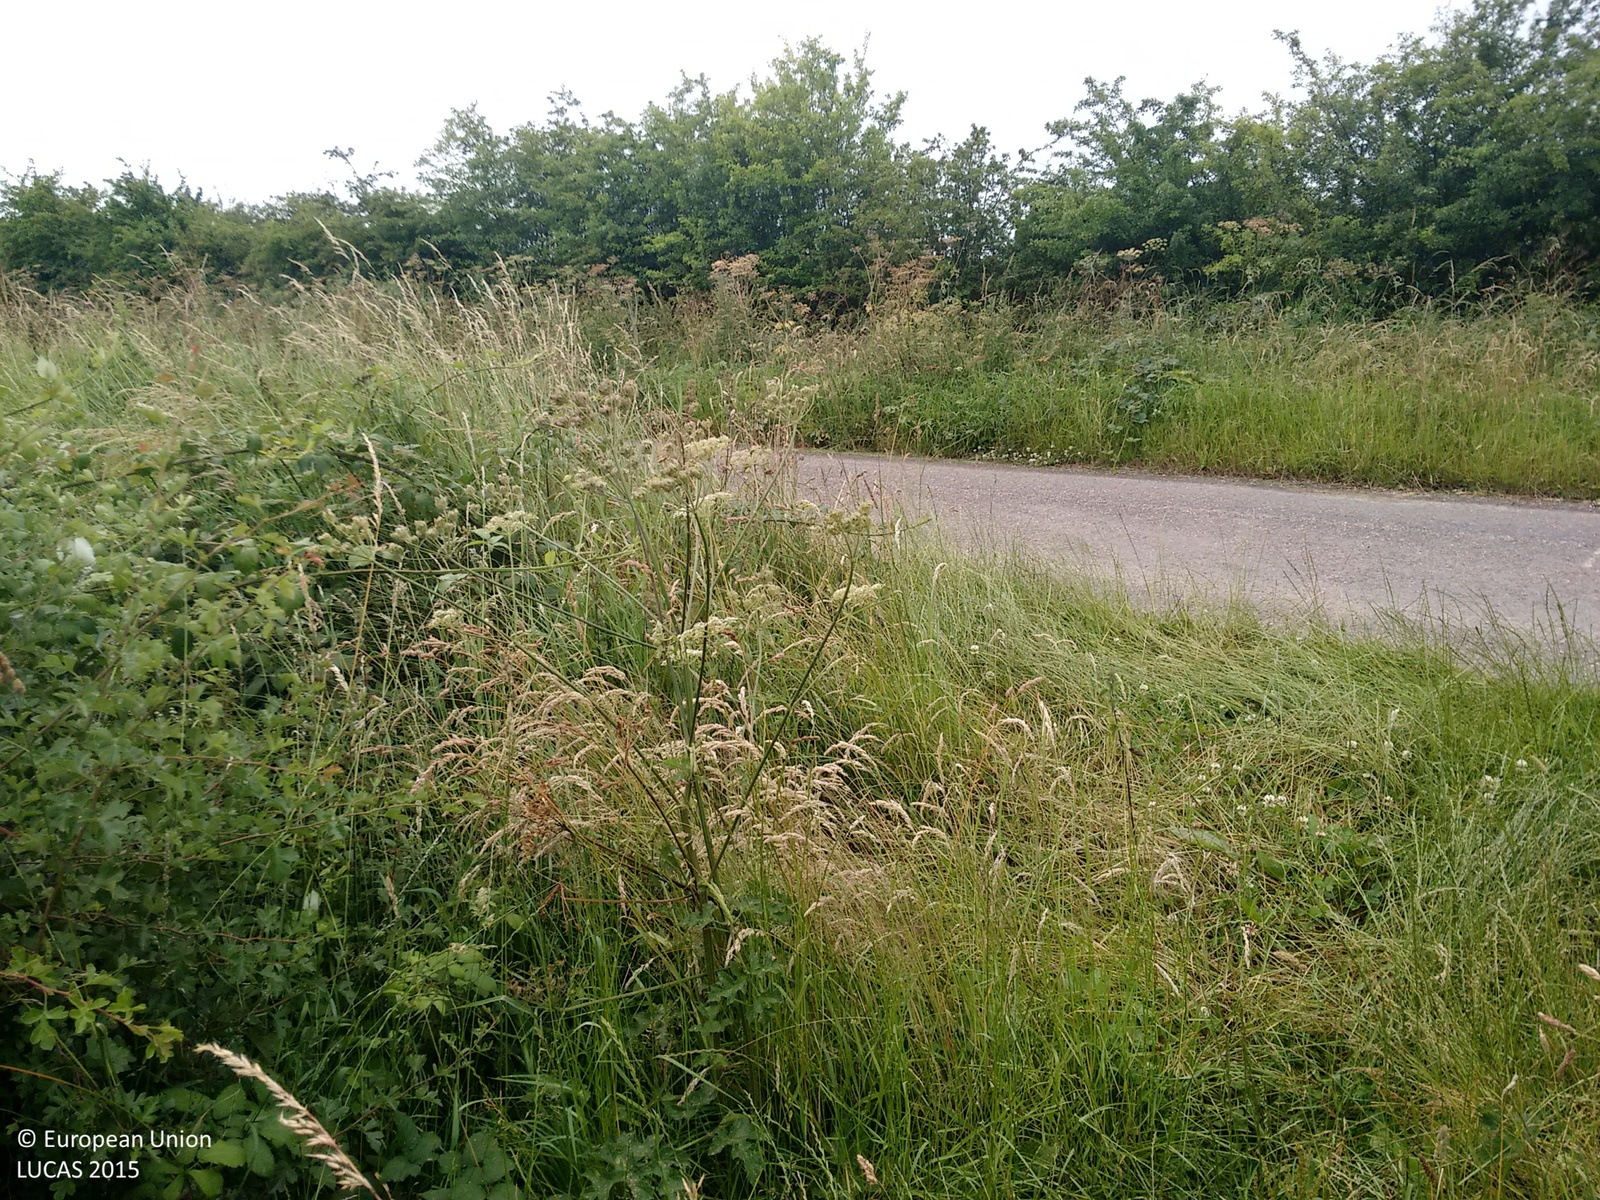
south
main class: Grassland
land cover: Grassland without tree/shrub cover
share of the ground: > 75 %
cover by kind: herbaceous plants 100 %
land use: Agriculture (excluding fallow land and kitchen gardens)
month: July
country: GB
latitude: 52.8817
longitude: -1.5681
